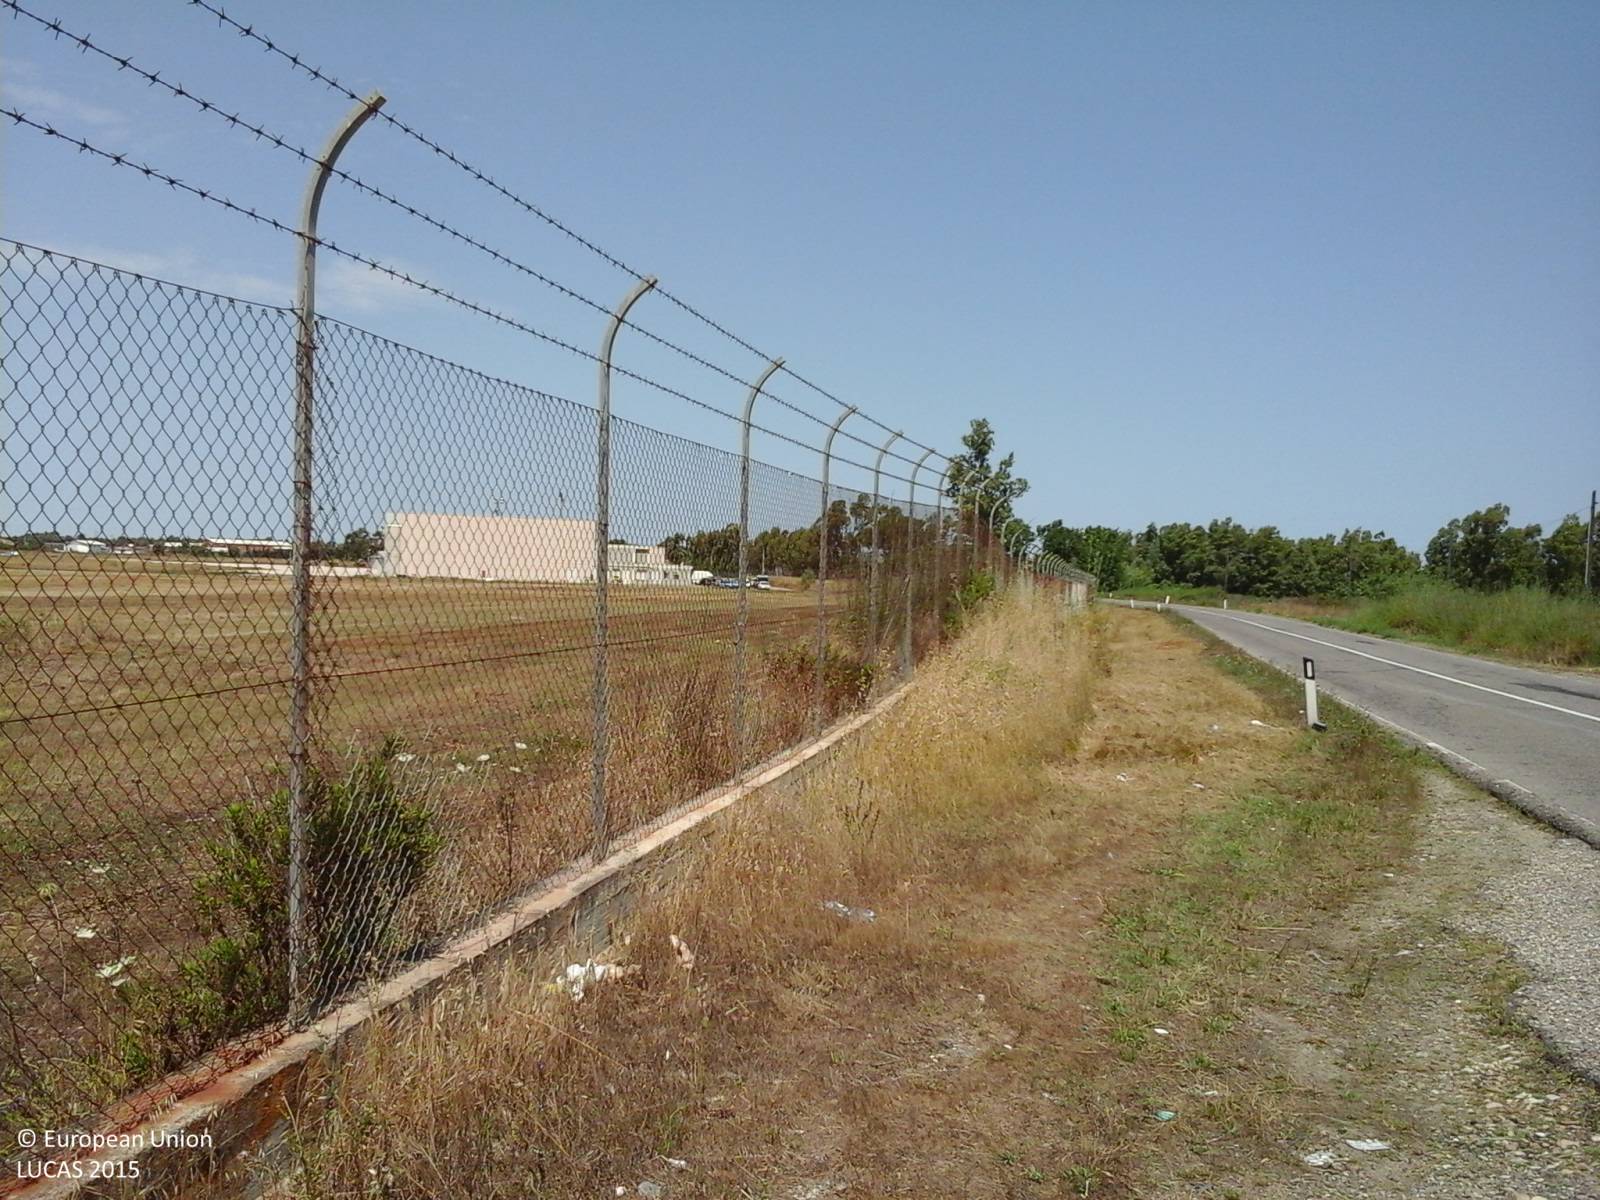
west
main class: Grassland
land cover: Grassland without tree/shrub cover
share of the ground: > 75 %
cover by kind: herbaceous plants 100 %
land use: Air transport
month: June
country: IT
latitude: 39.8957
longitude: 8.6392
